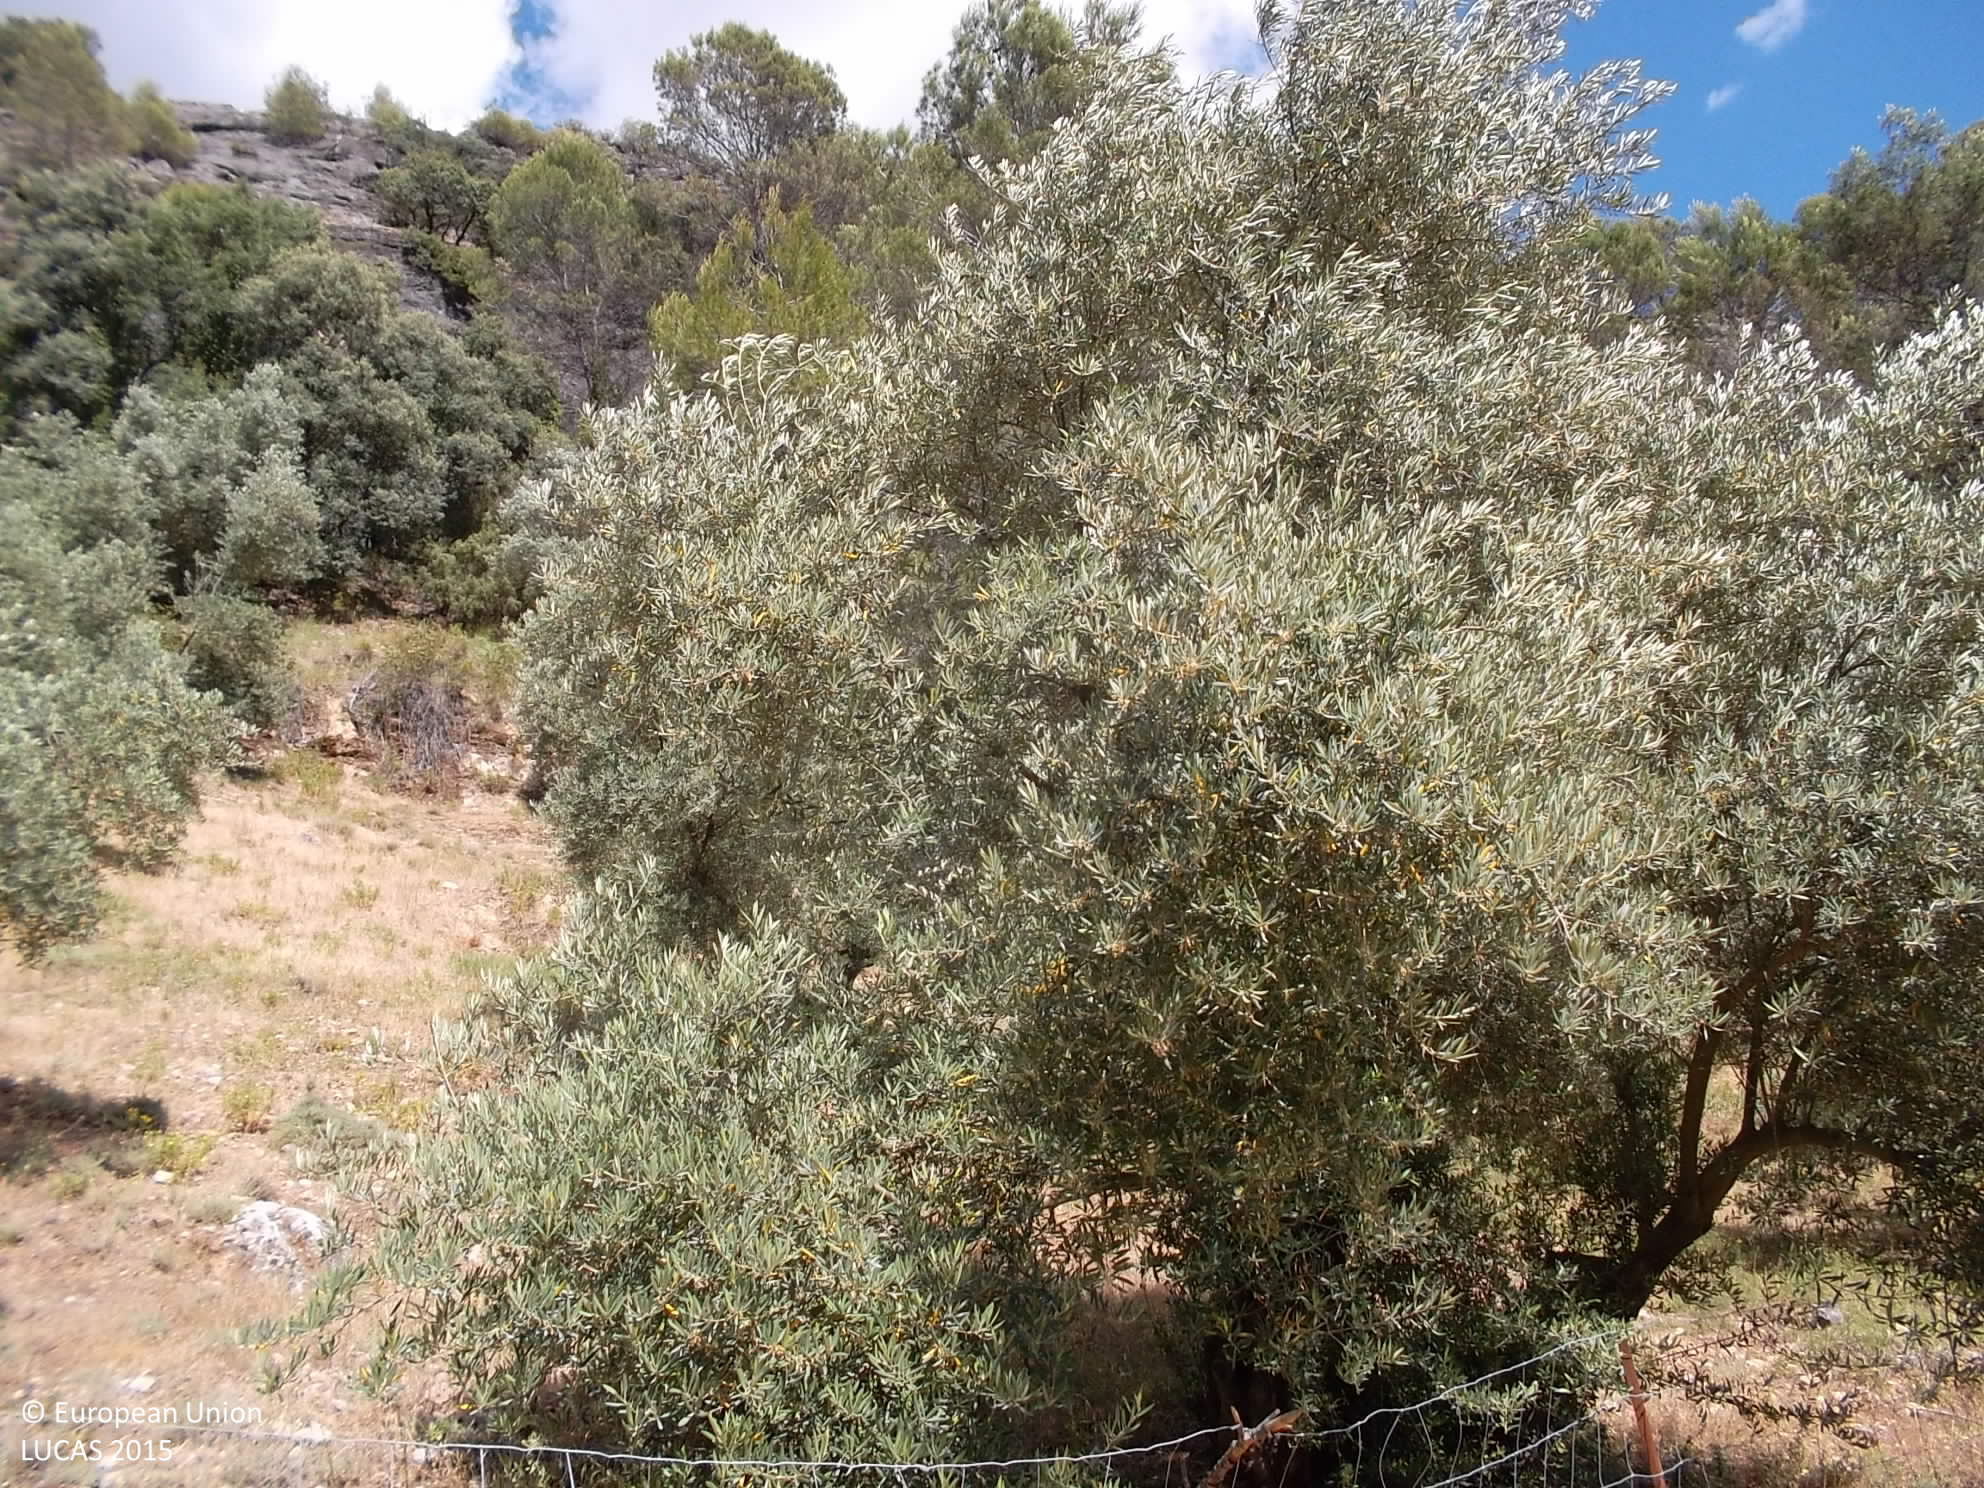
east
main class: Woodland
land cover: Pine dominated mixed woodland
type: alpine coniferous forest
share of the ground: 25 - 50 %
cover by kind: coniferous forest trees 40 %, shrubs 30 %, broadleaved forest trees 20 %, consolidated bare surface 10 %
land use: Forestry
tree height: > 5 m
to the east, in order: Pine dominated mixed woodland; Shrubland with sparse tree cover; Rock outcrops; Pine dominated mixed woodland; Rivers and streams; Fences; Broadleaved woodland; Grassland with sparse tree/shrub cover; Rivers and streams; Olive groves; Tracks
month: June
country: ES
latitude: 38.0106
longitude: -2.9690
